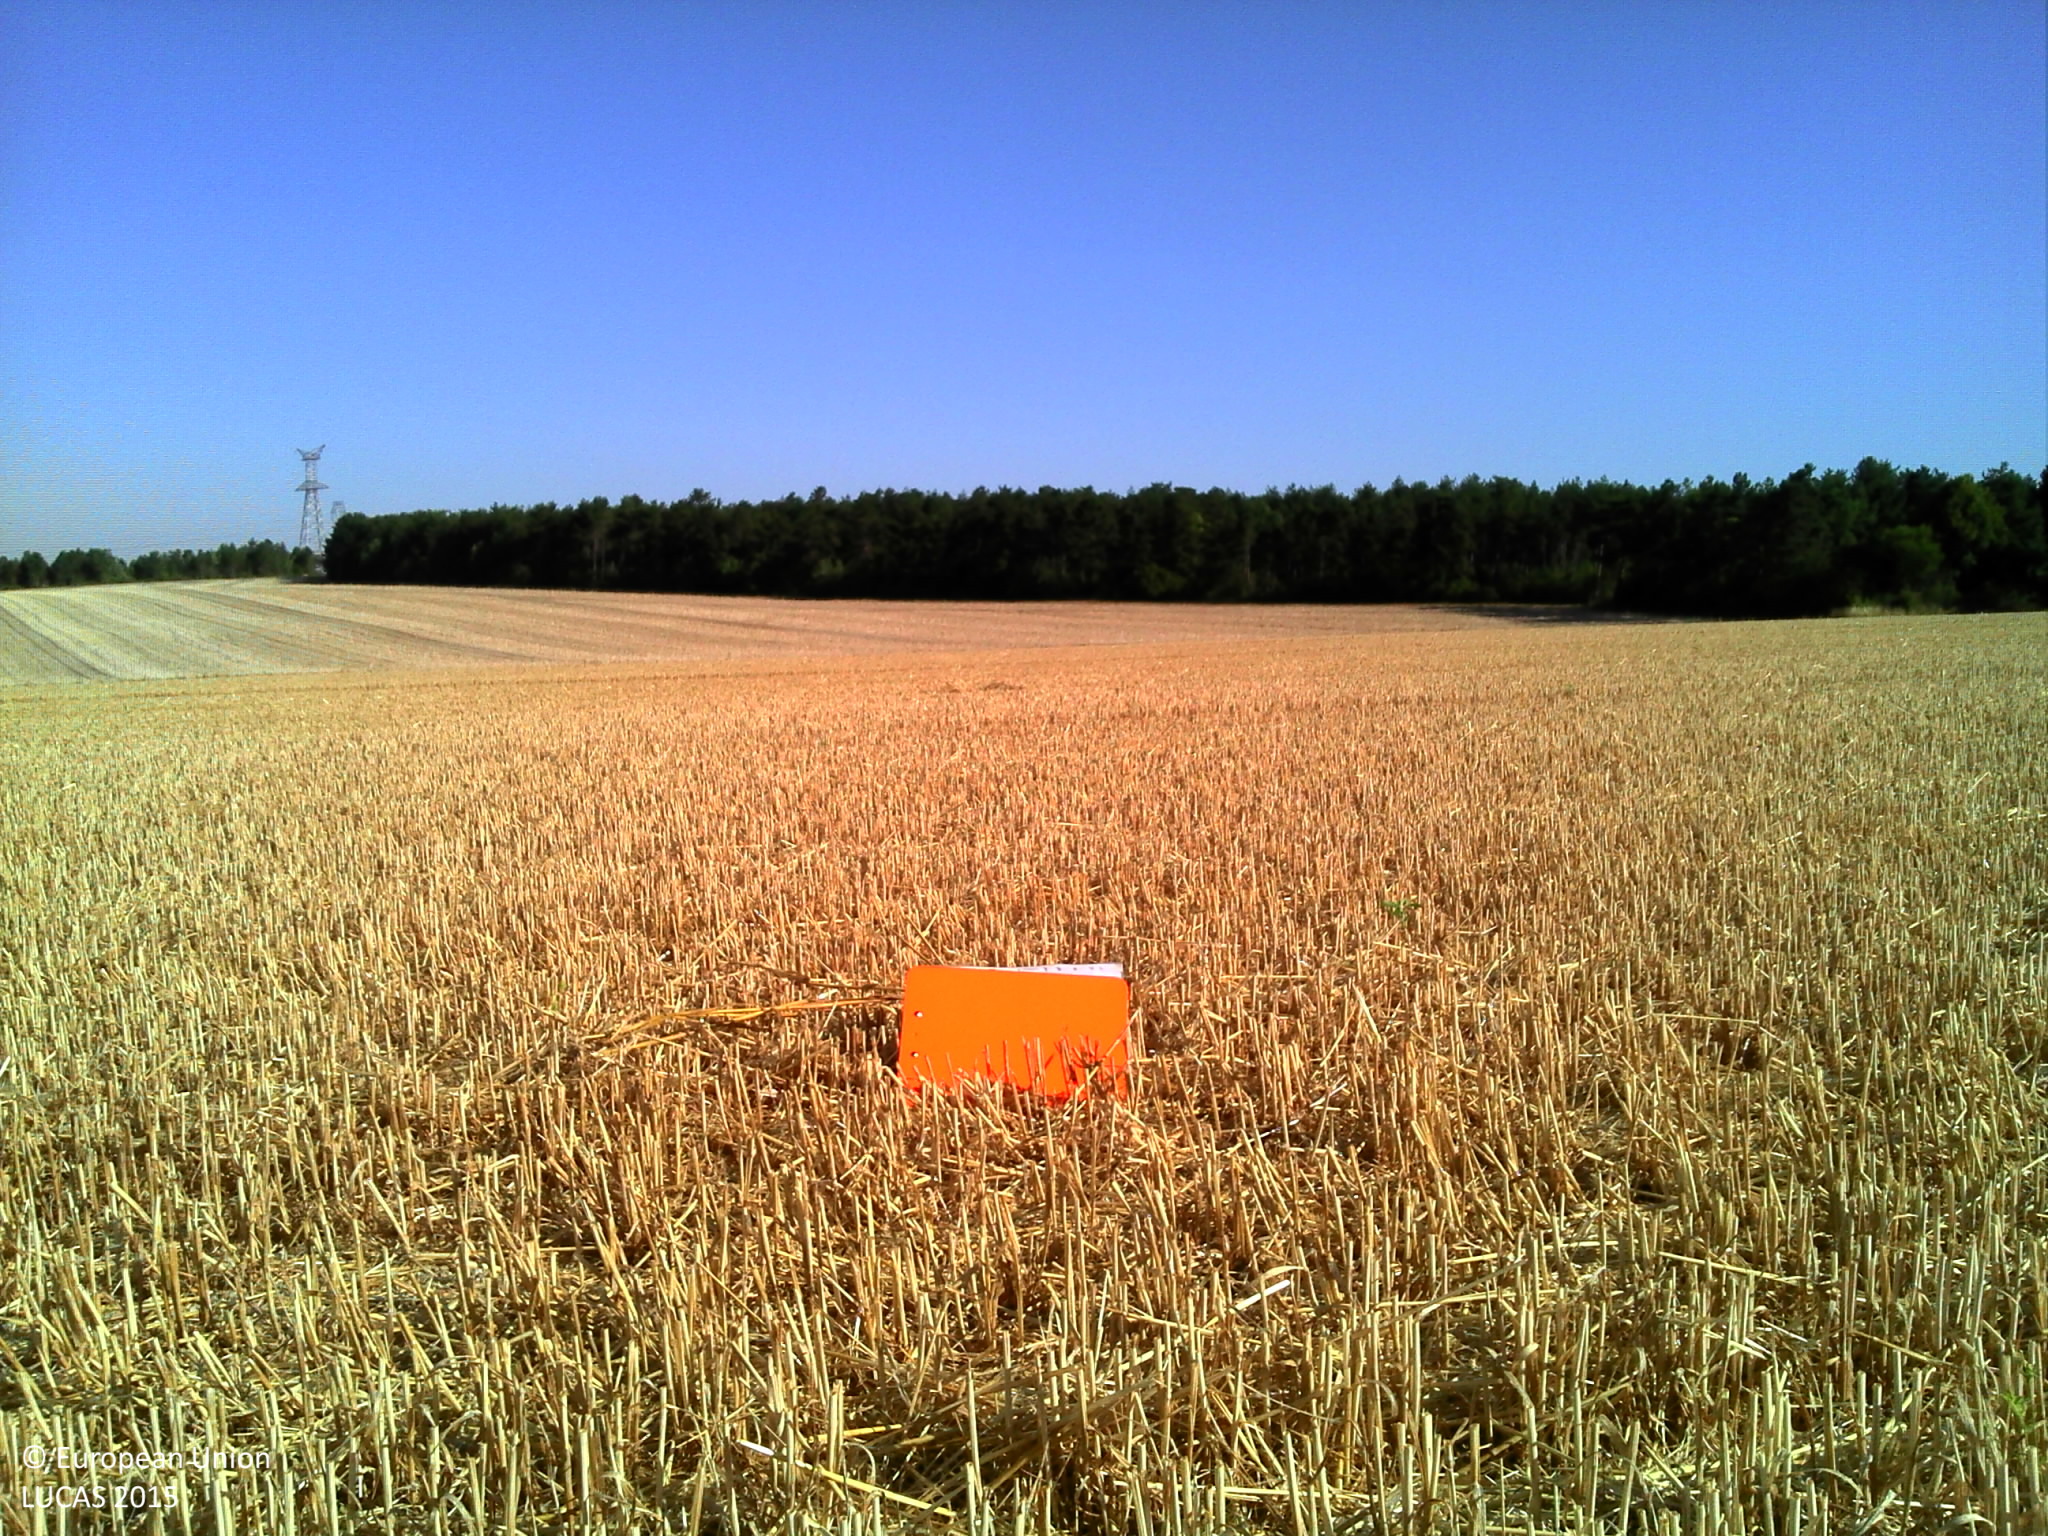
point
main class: Cropland
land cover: Common wheat
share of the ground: > 75 %
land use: Agriculture (excluding fallow land and kitchen gardens)
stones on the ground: < 10 %
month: August
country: FR
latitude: 49.2481
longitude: 4.2948
